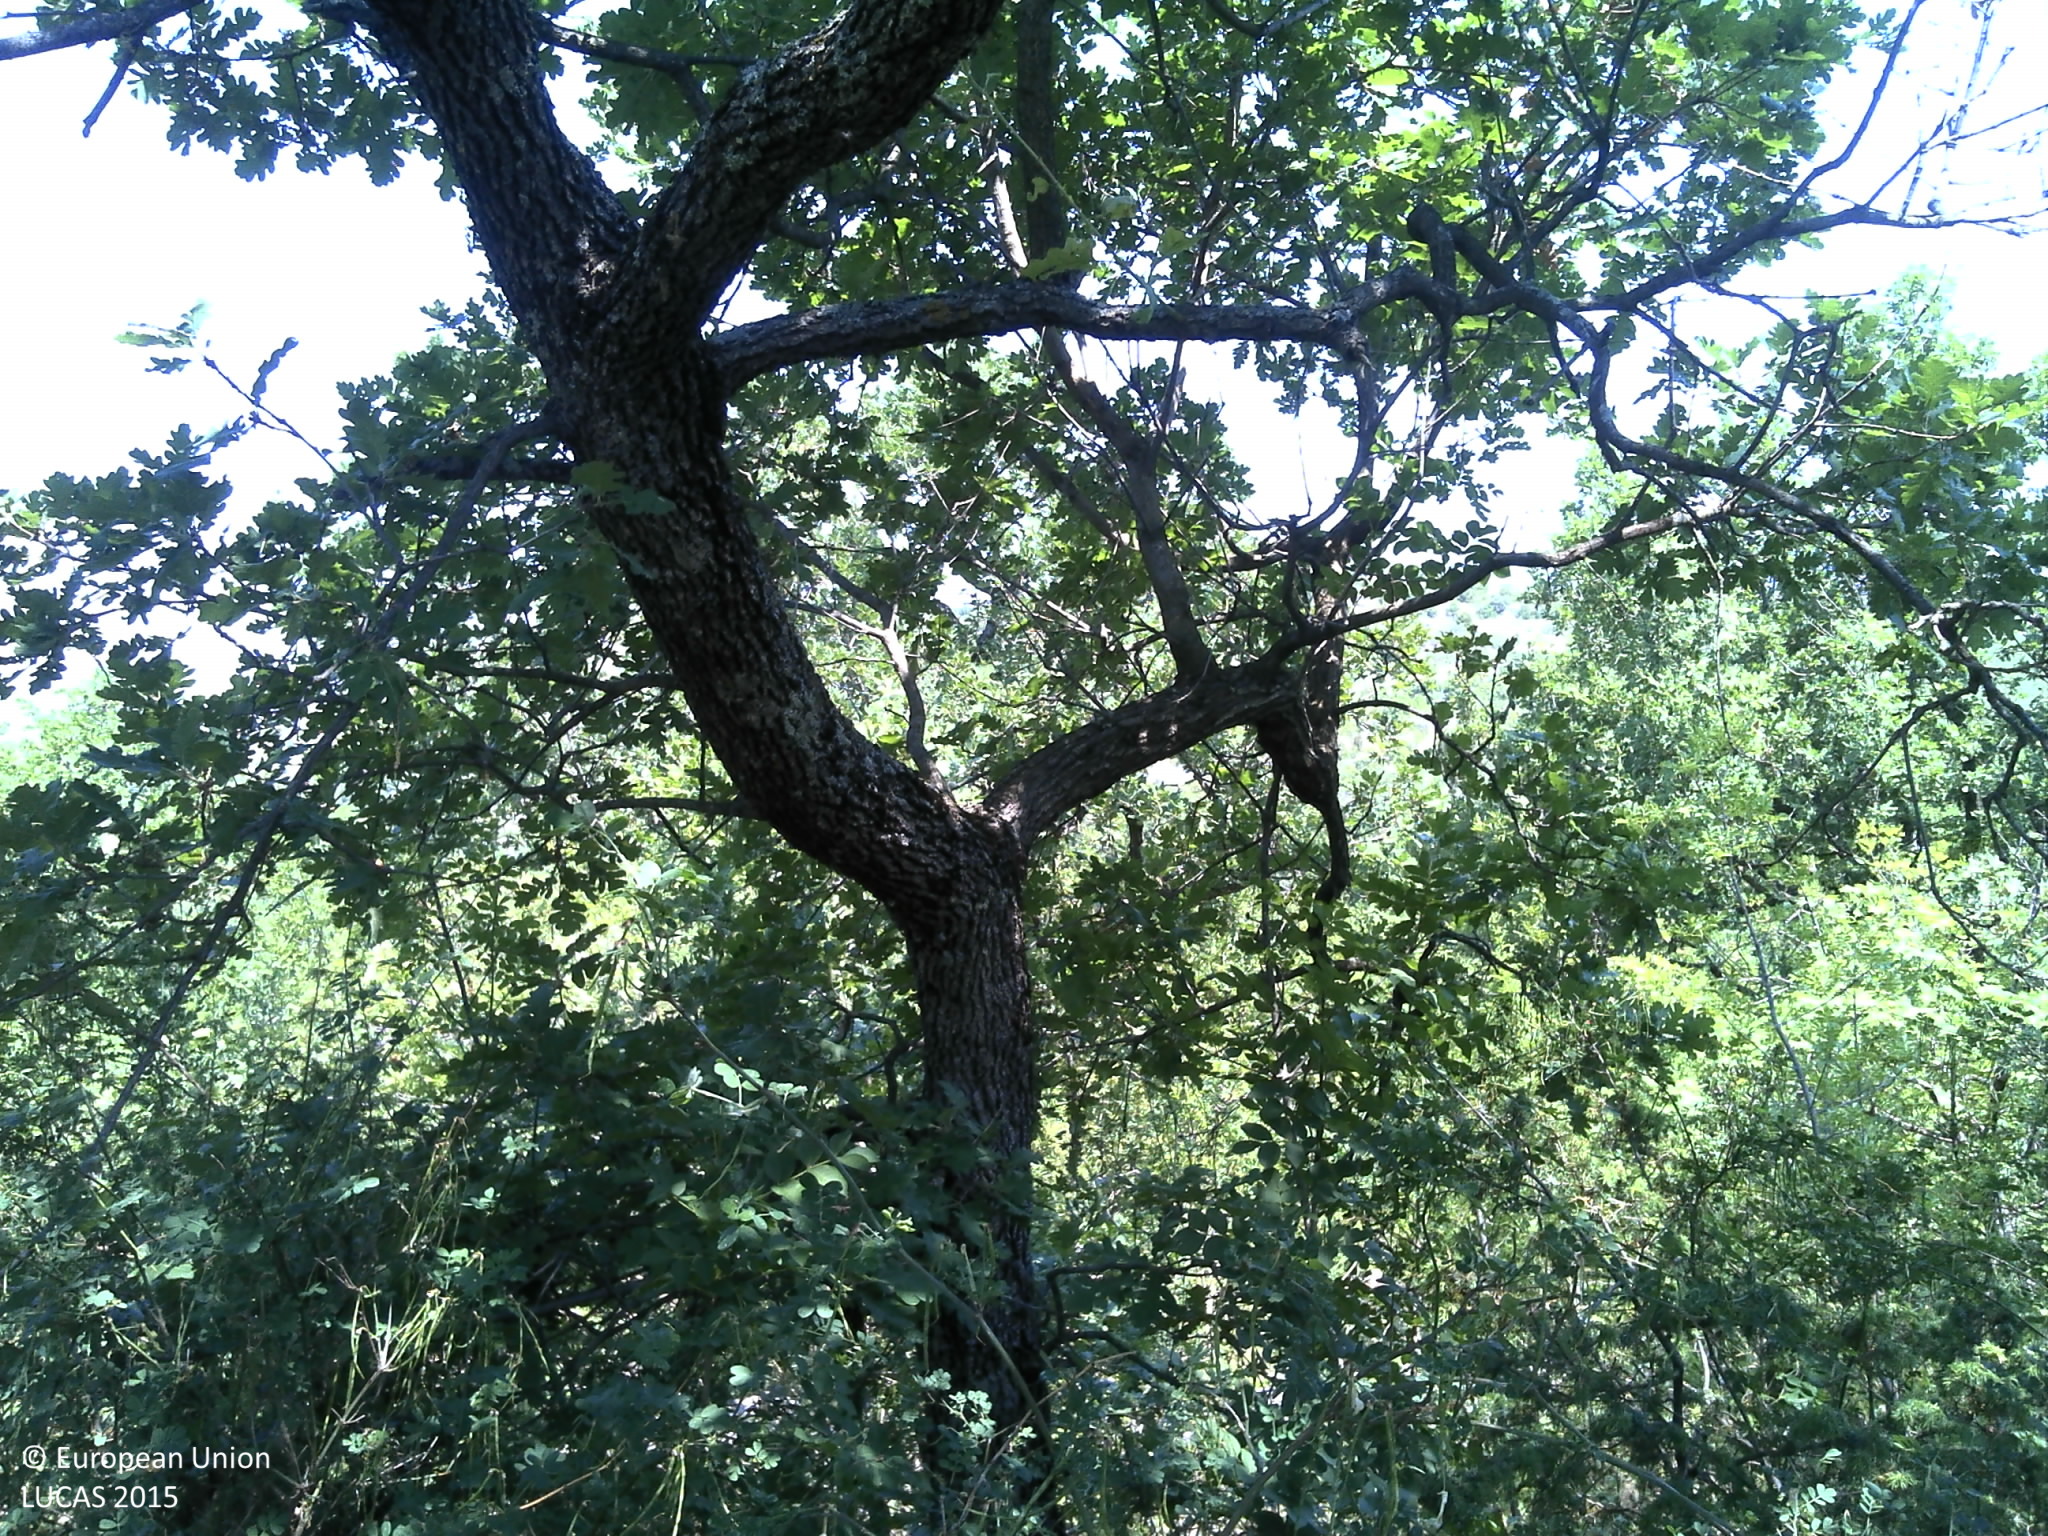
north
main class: Woodland
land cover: Broadleaved woodland
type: thermophilous deciduous forest
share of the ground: 50 - 75 %
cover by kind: broadleaved forest trees 60 %, shrubs 20 %, unconsolidated bare surface 15 %, lichens and mosses 5 %
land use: Semi-natural and natural areas not in use
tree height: > 5 m
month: June
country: HR
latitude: 43.5759
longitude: 16.0707
